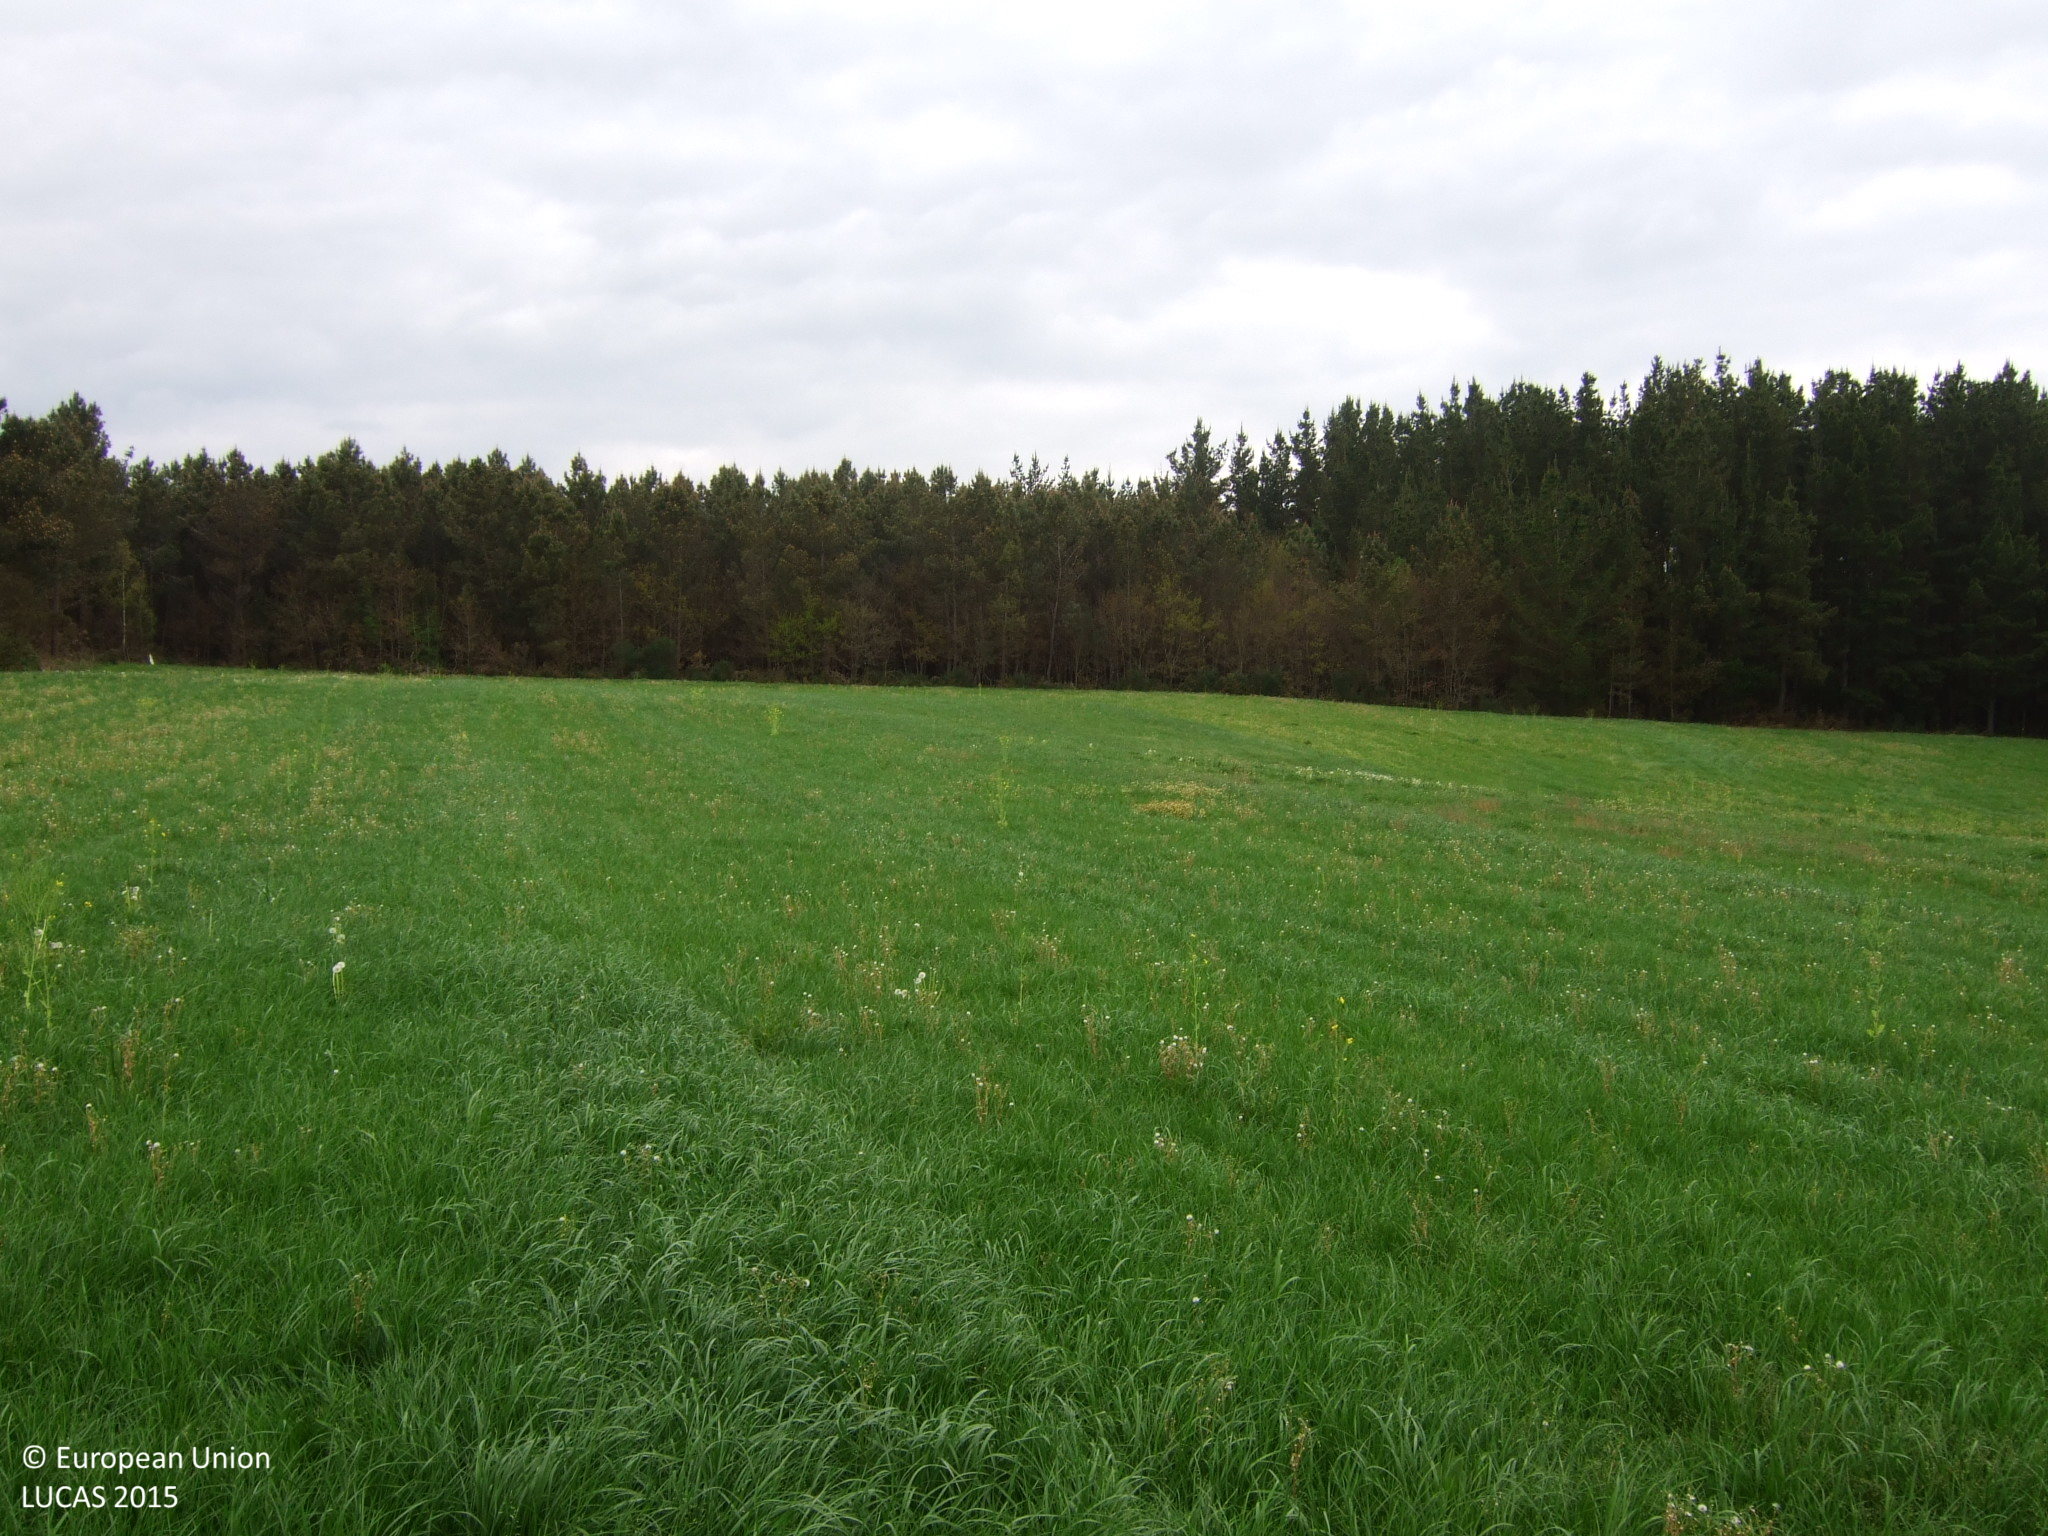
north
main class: Cropland
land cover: Temporary grasslands
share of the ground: > 75 %
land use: Agriculture (excluding fallow land and kitchen gardens)
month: April
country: ES
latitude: 42.8606
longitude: -7.5401
